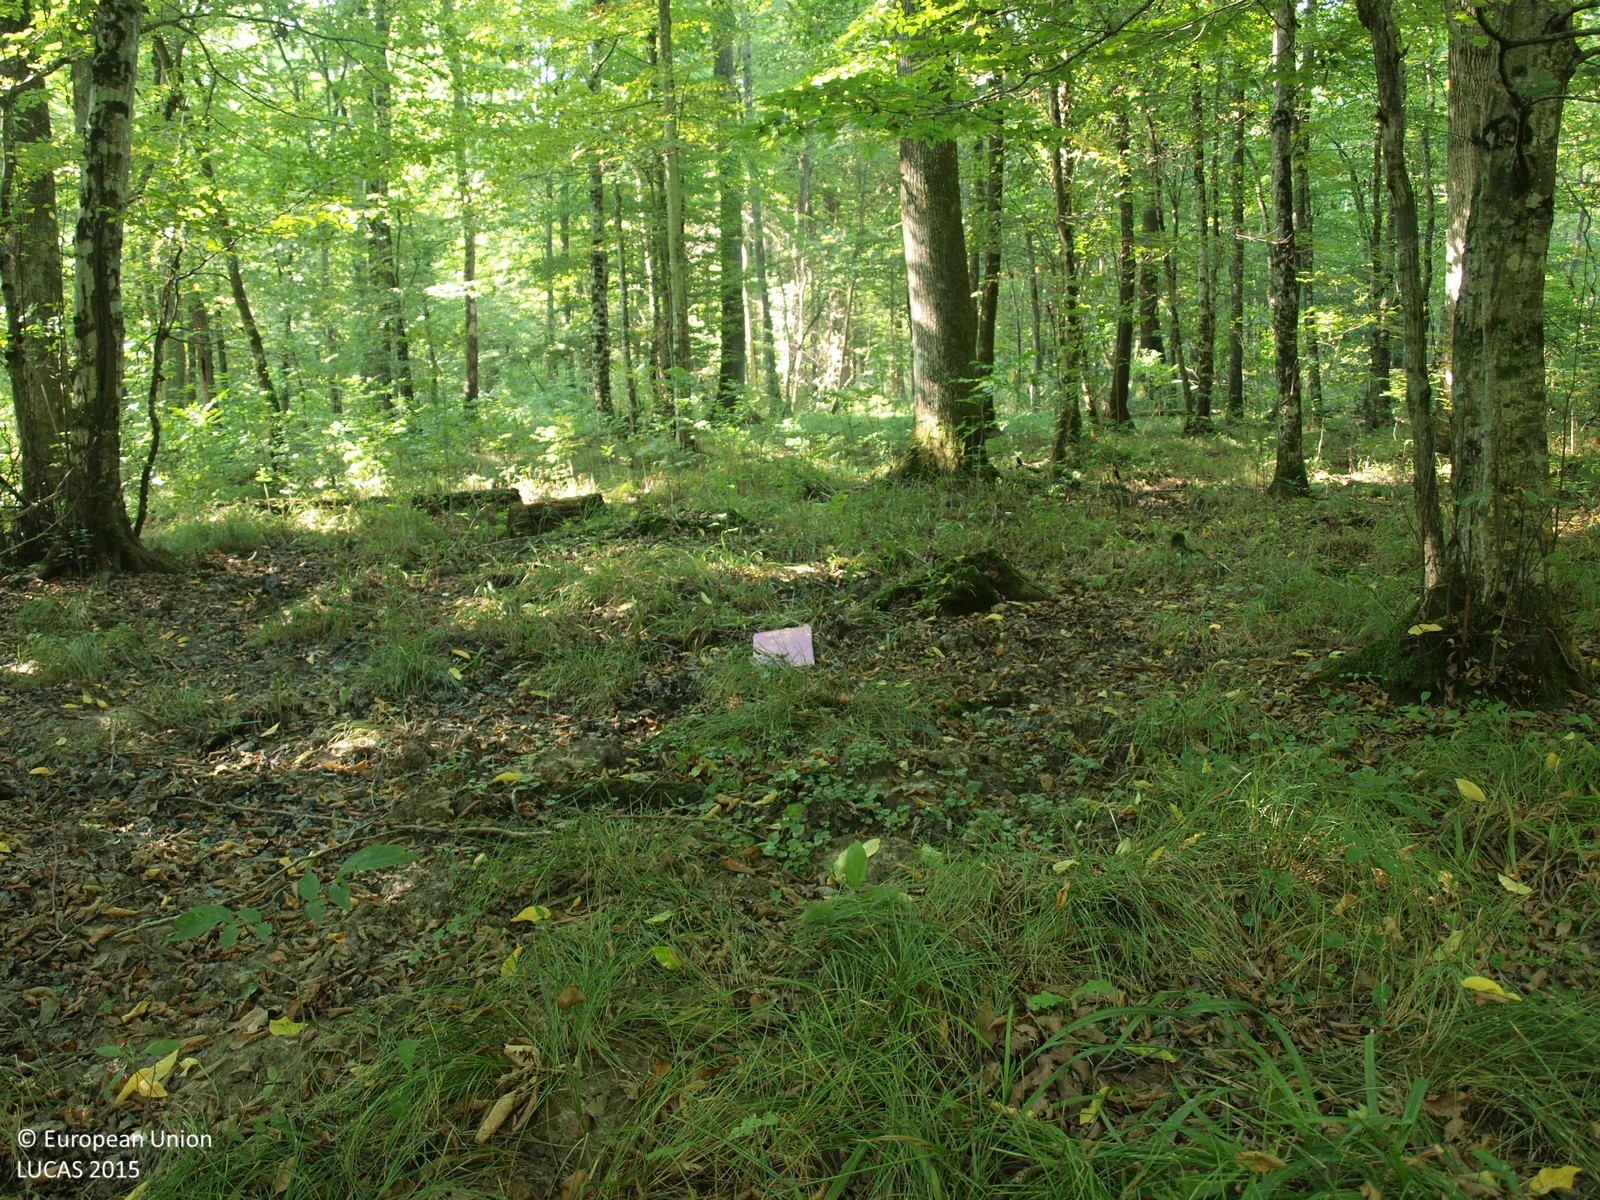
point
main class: Woodland
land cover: Broadleaved woodland
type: floodplain forest
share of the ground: > 75 %
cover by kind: broadleaved forest trees 100 %
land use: Forestry
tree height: > 5 m
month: August
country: HR
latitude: 45.6145
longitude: 16.4487
